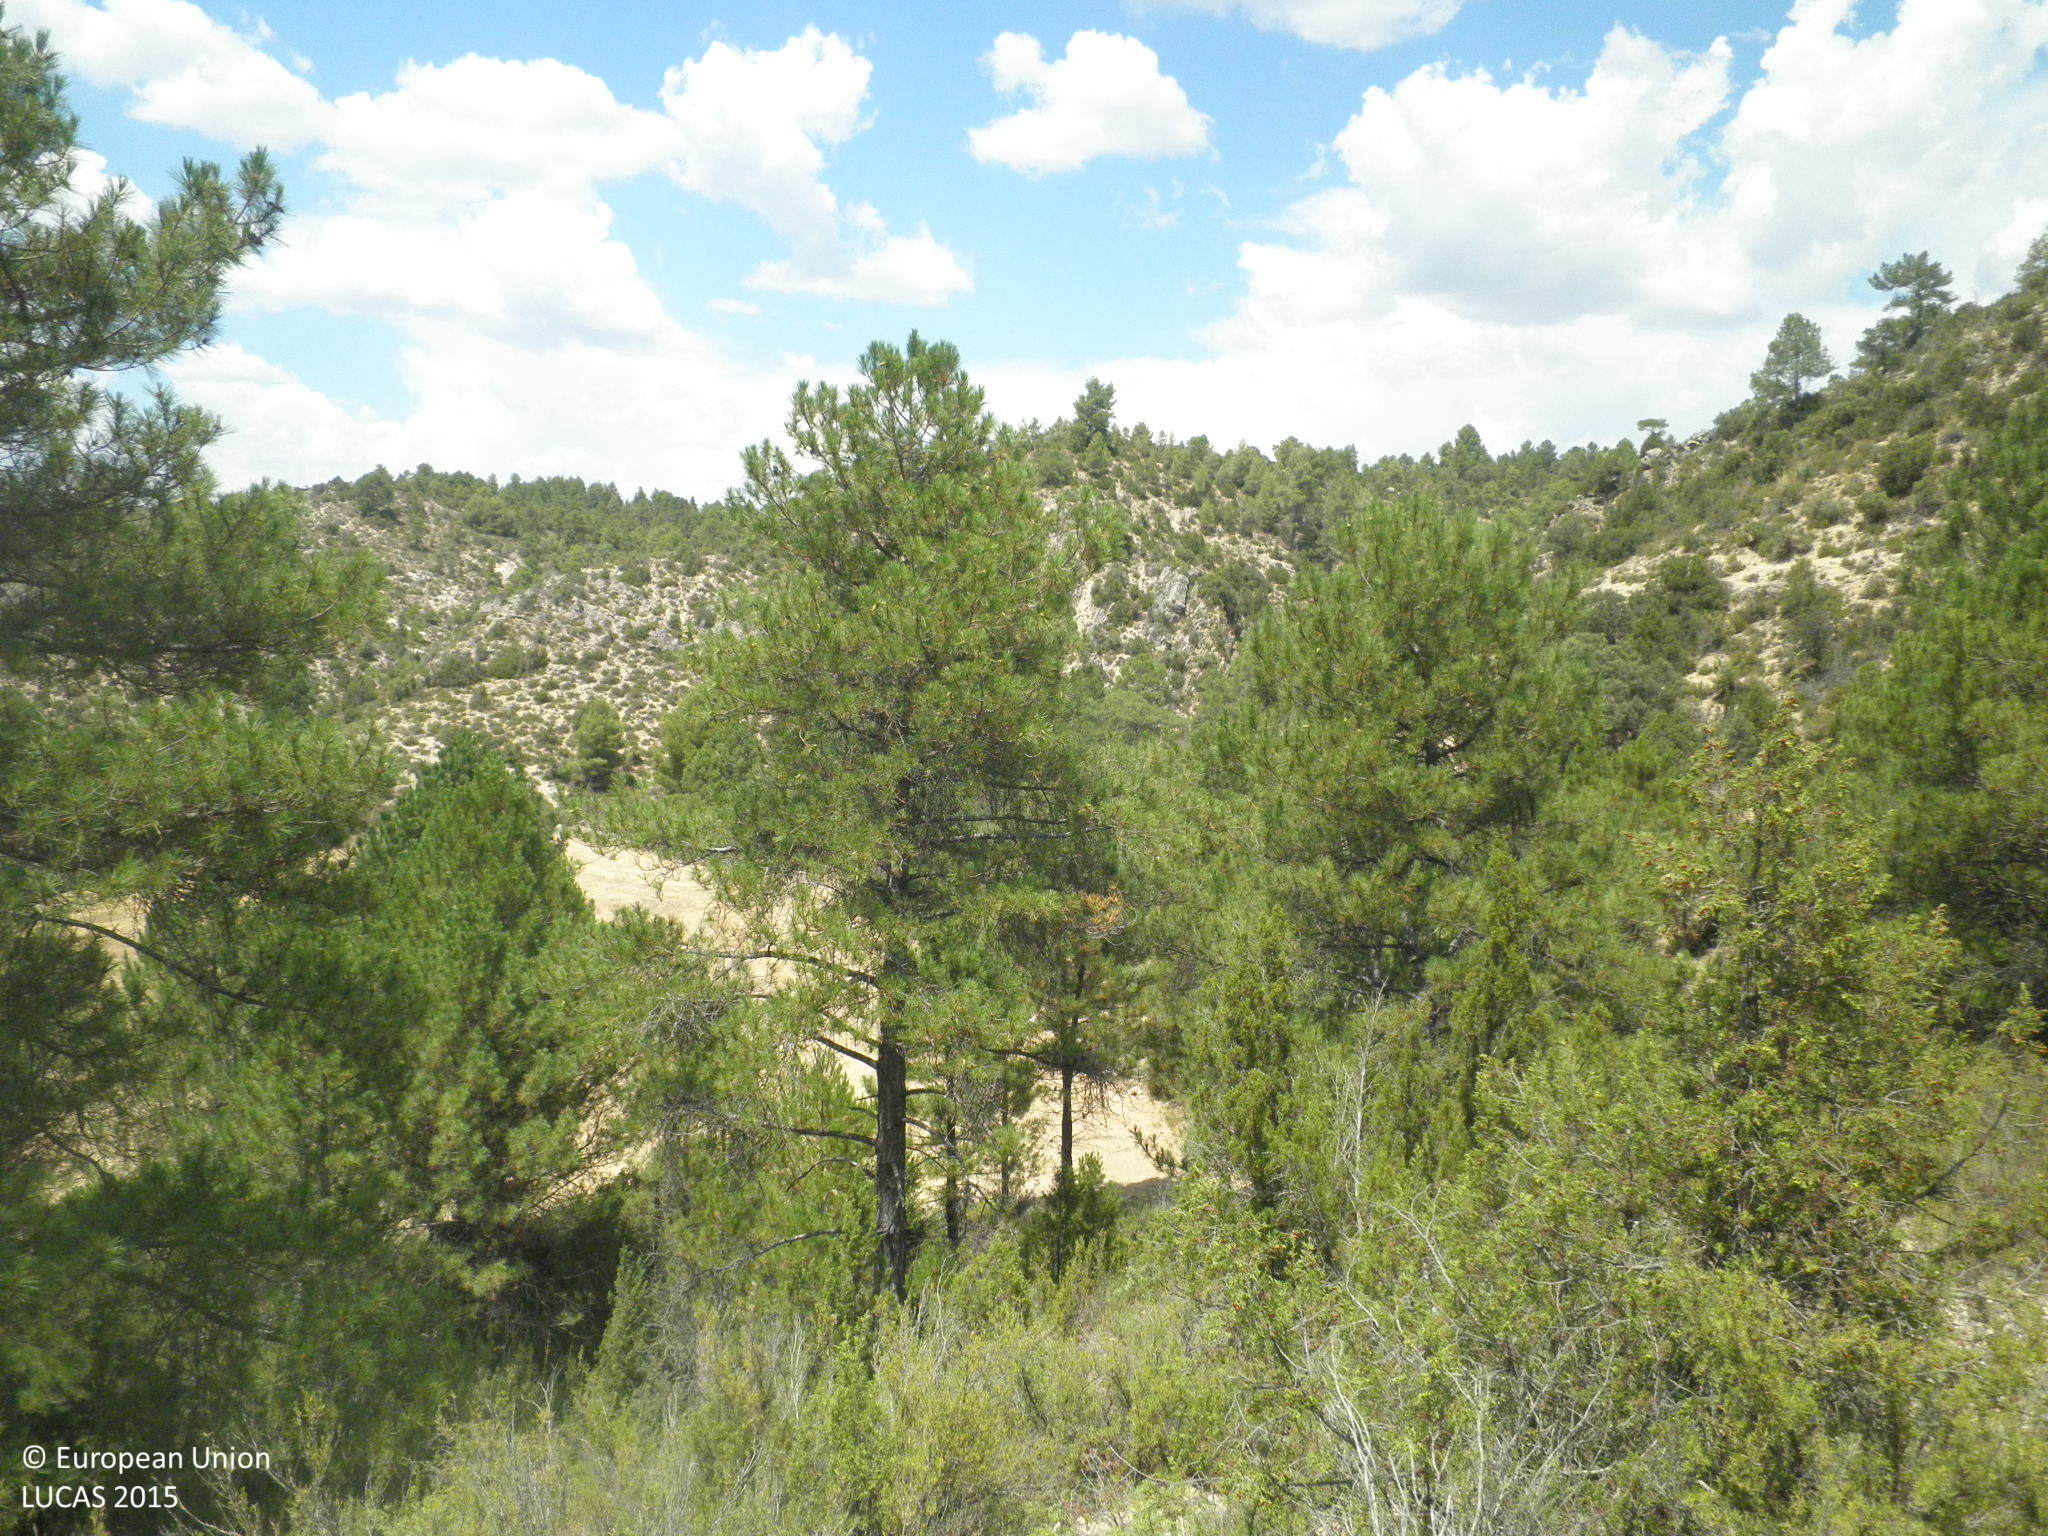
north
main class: Woodland
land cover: Pine dominated coniferous woodland
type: coniferous forest of the mediterranean region
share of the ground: 10 - 25 %
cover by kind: unconsolidated bare surface 50 %, shrubs 40 %, coniferous forest trees 10 %
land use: Semi-natural and natural areas not in use
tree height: > 5 m
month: July
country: ES
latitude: 39.7346
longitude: -1.8056
